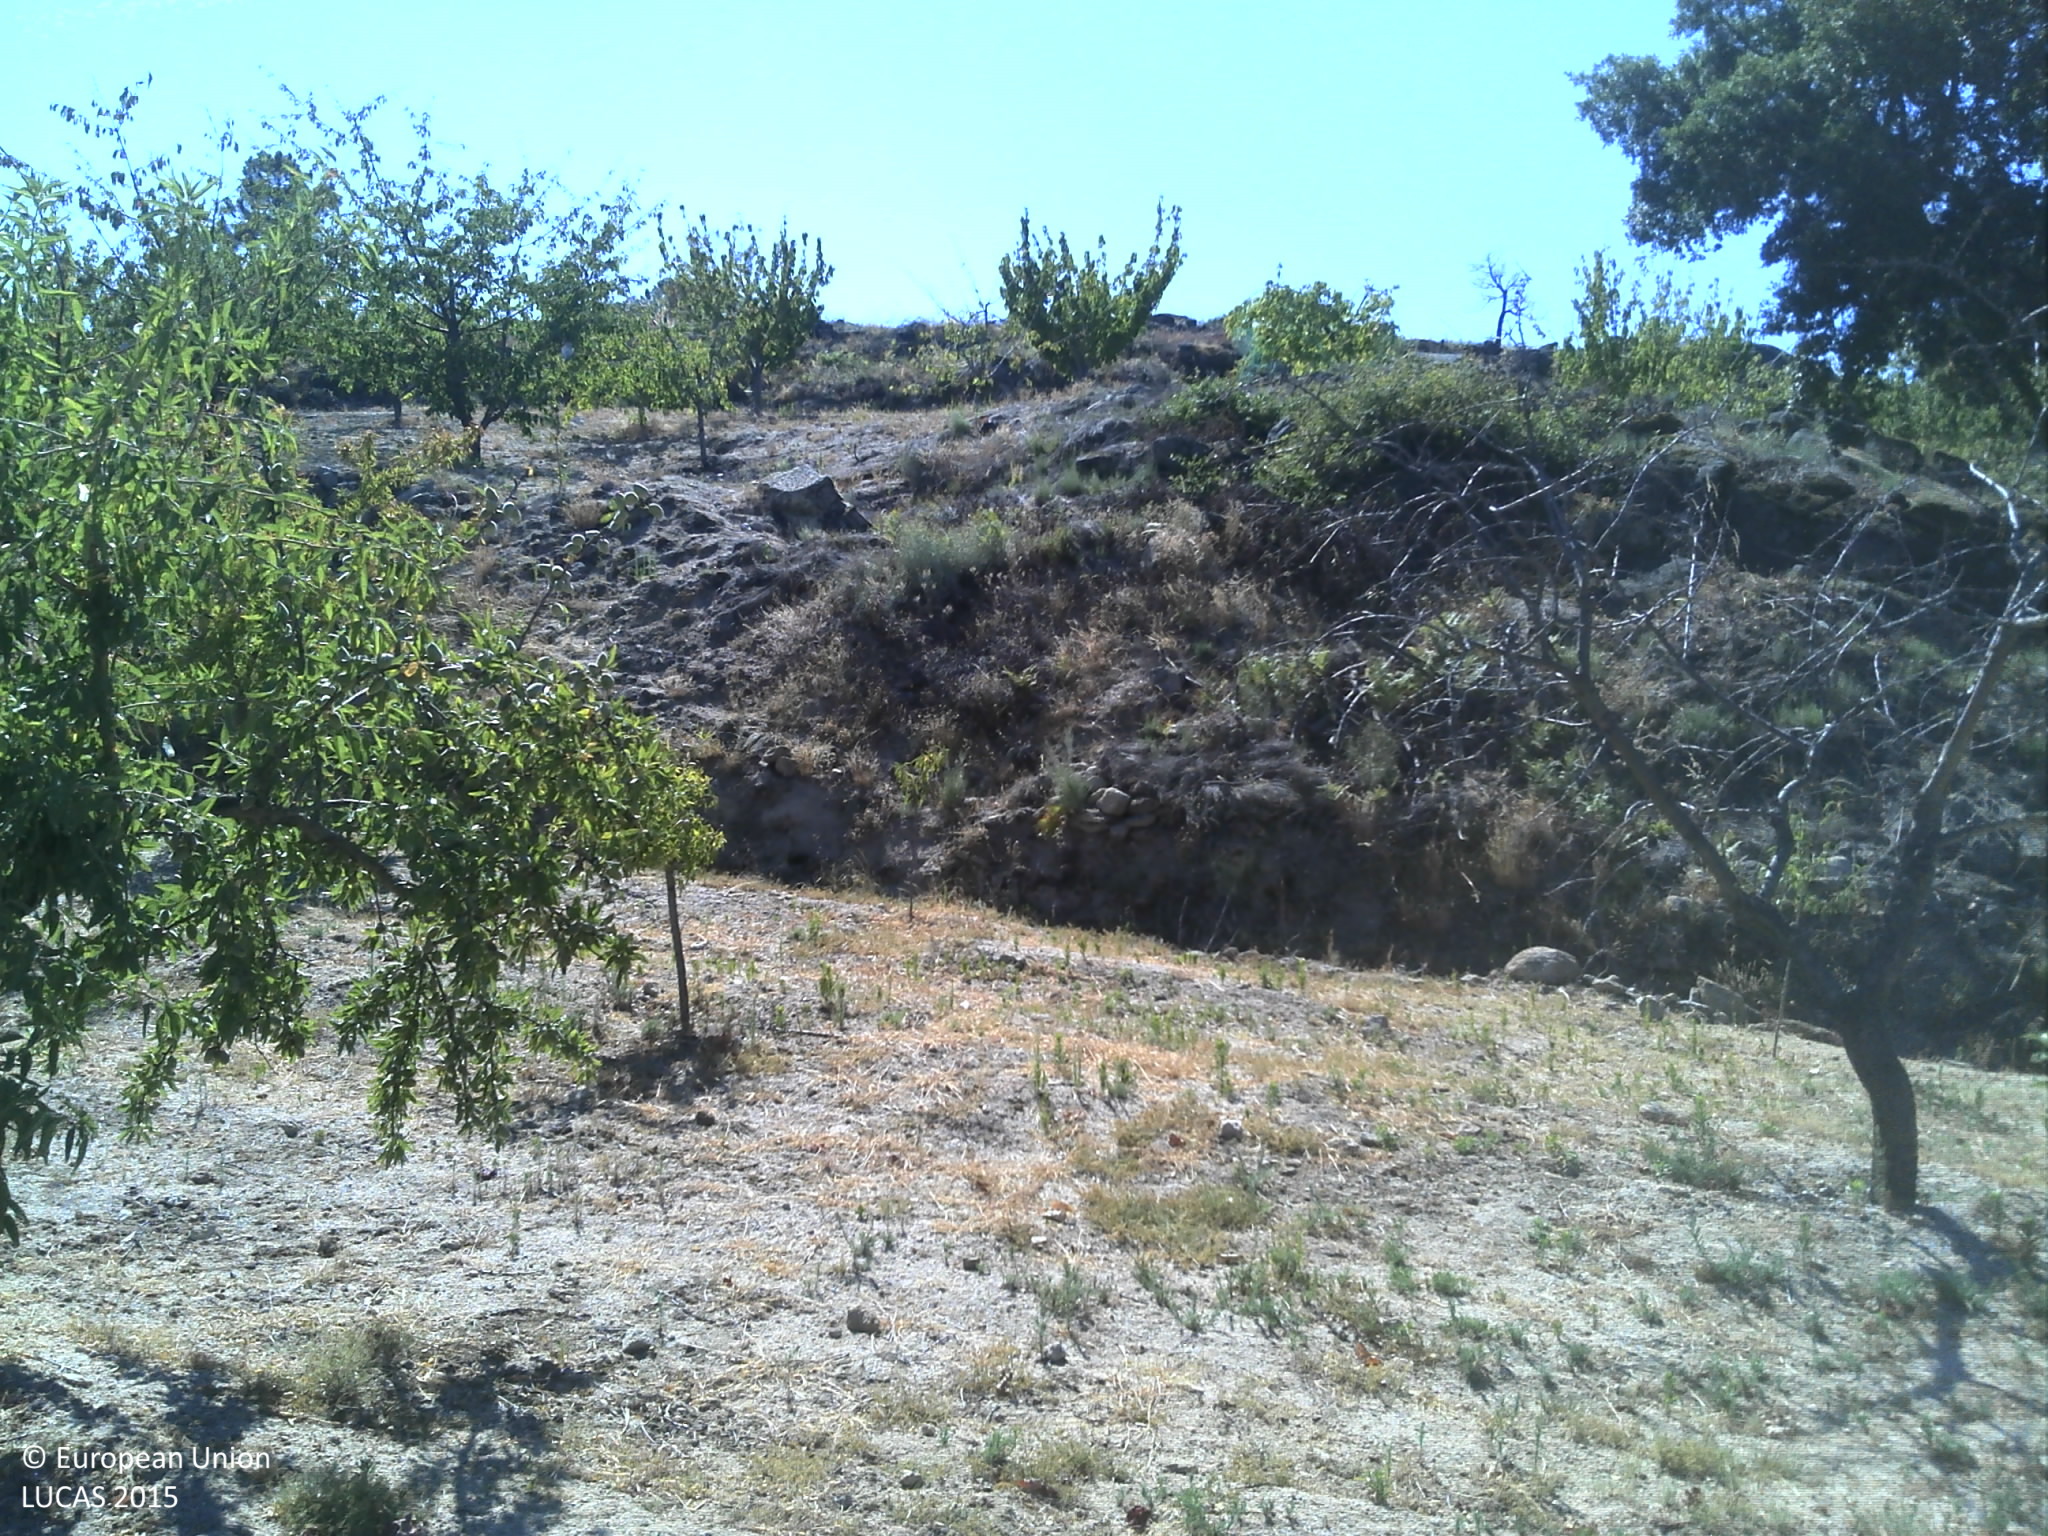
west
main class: Cropland
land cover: Vineyards
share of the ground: 10 - 25 %
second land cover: Other bare soil
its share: > 75 %
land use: Agriculture (excluding fallow land and kitchen gardens)
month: July
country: PT
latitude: 41.2841
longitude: -7.1777
